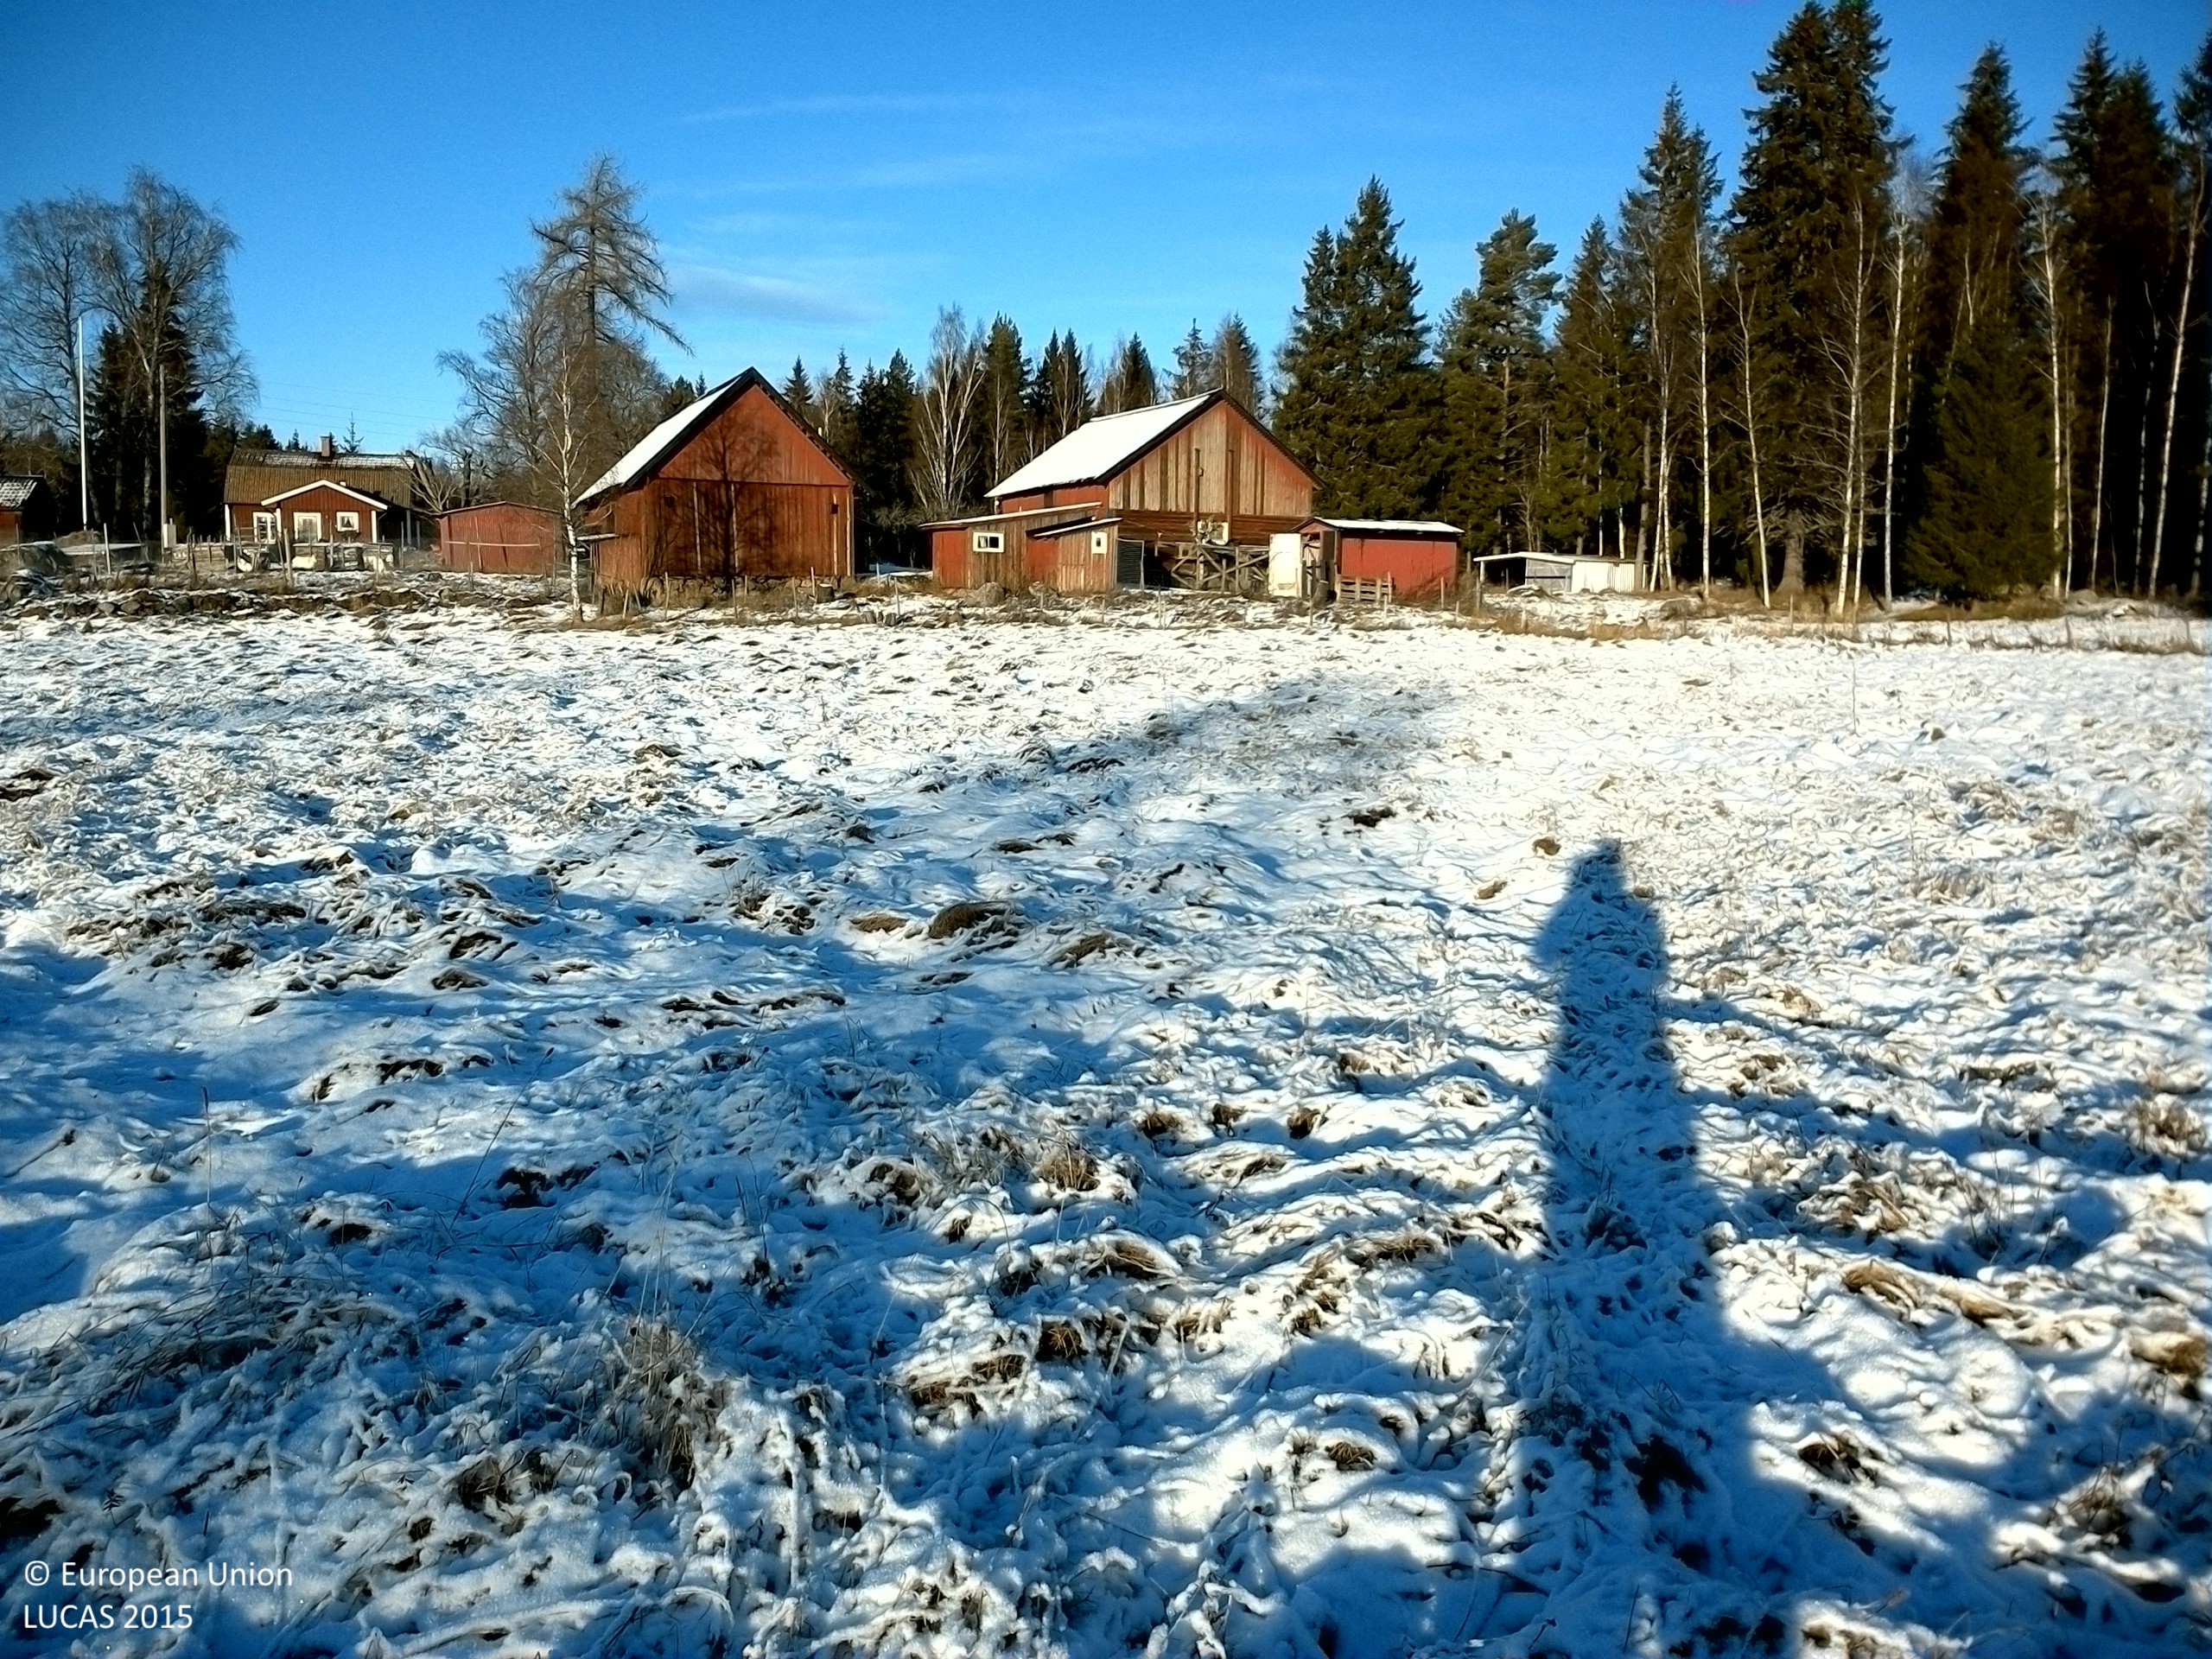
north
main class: Grassland
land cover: Grassland without tree/shrub cover
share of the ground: > 75 %
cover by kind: herbaceous plants 100 %
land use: Agriculture (excluding fallow land and kitchen gardens)
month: December
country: SE
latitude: 59.6578
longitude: 16.3629
